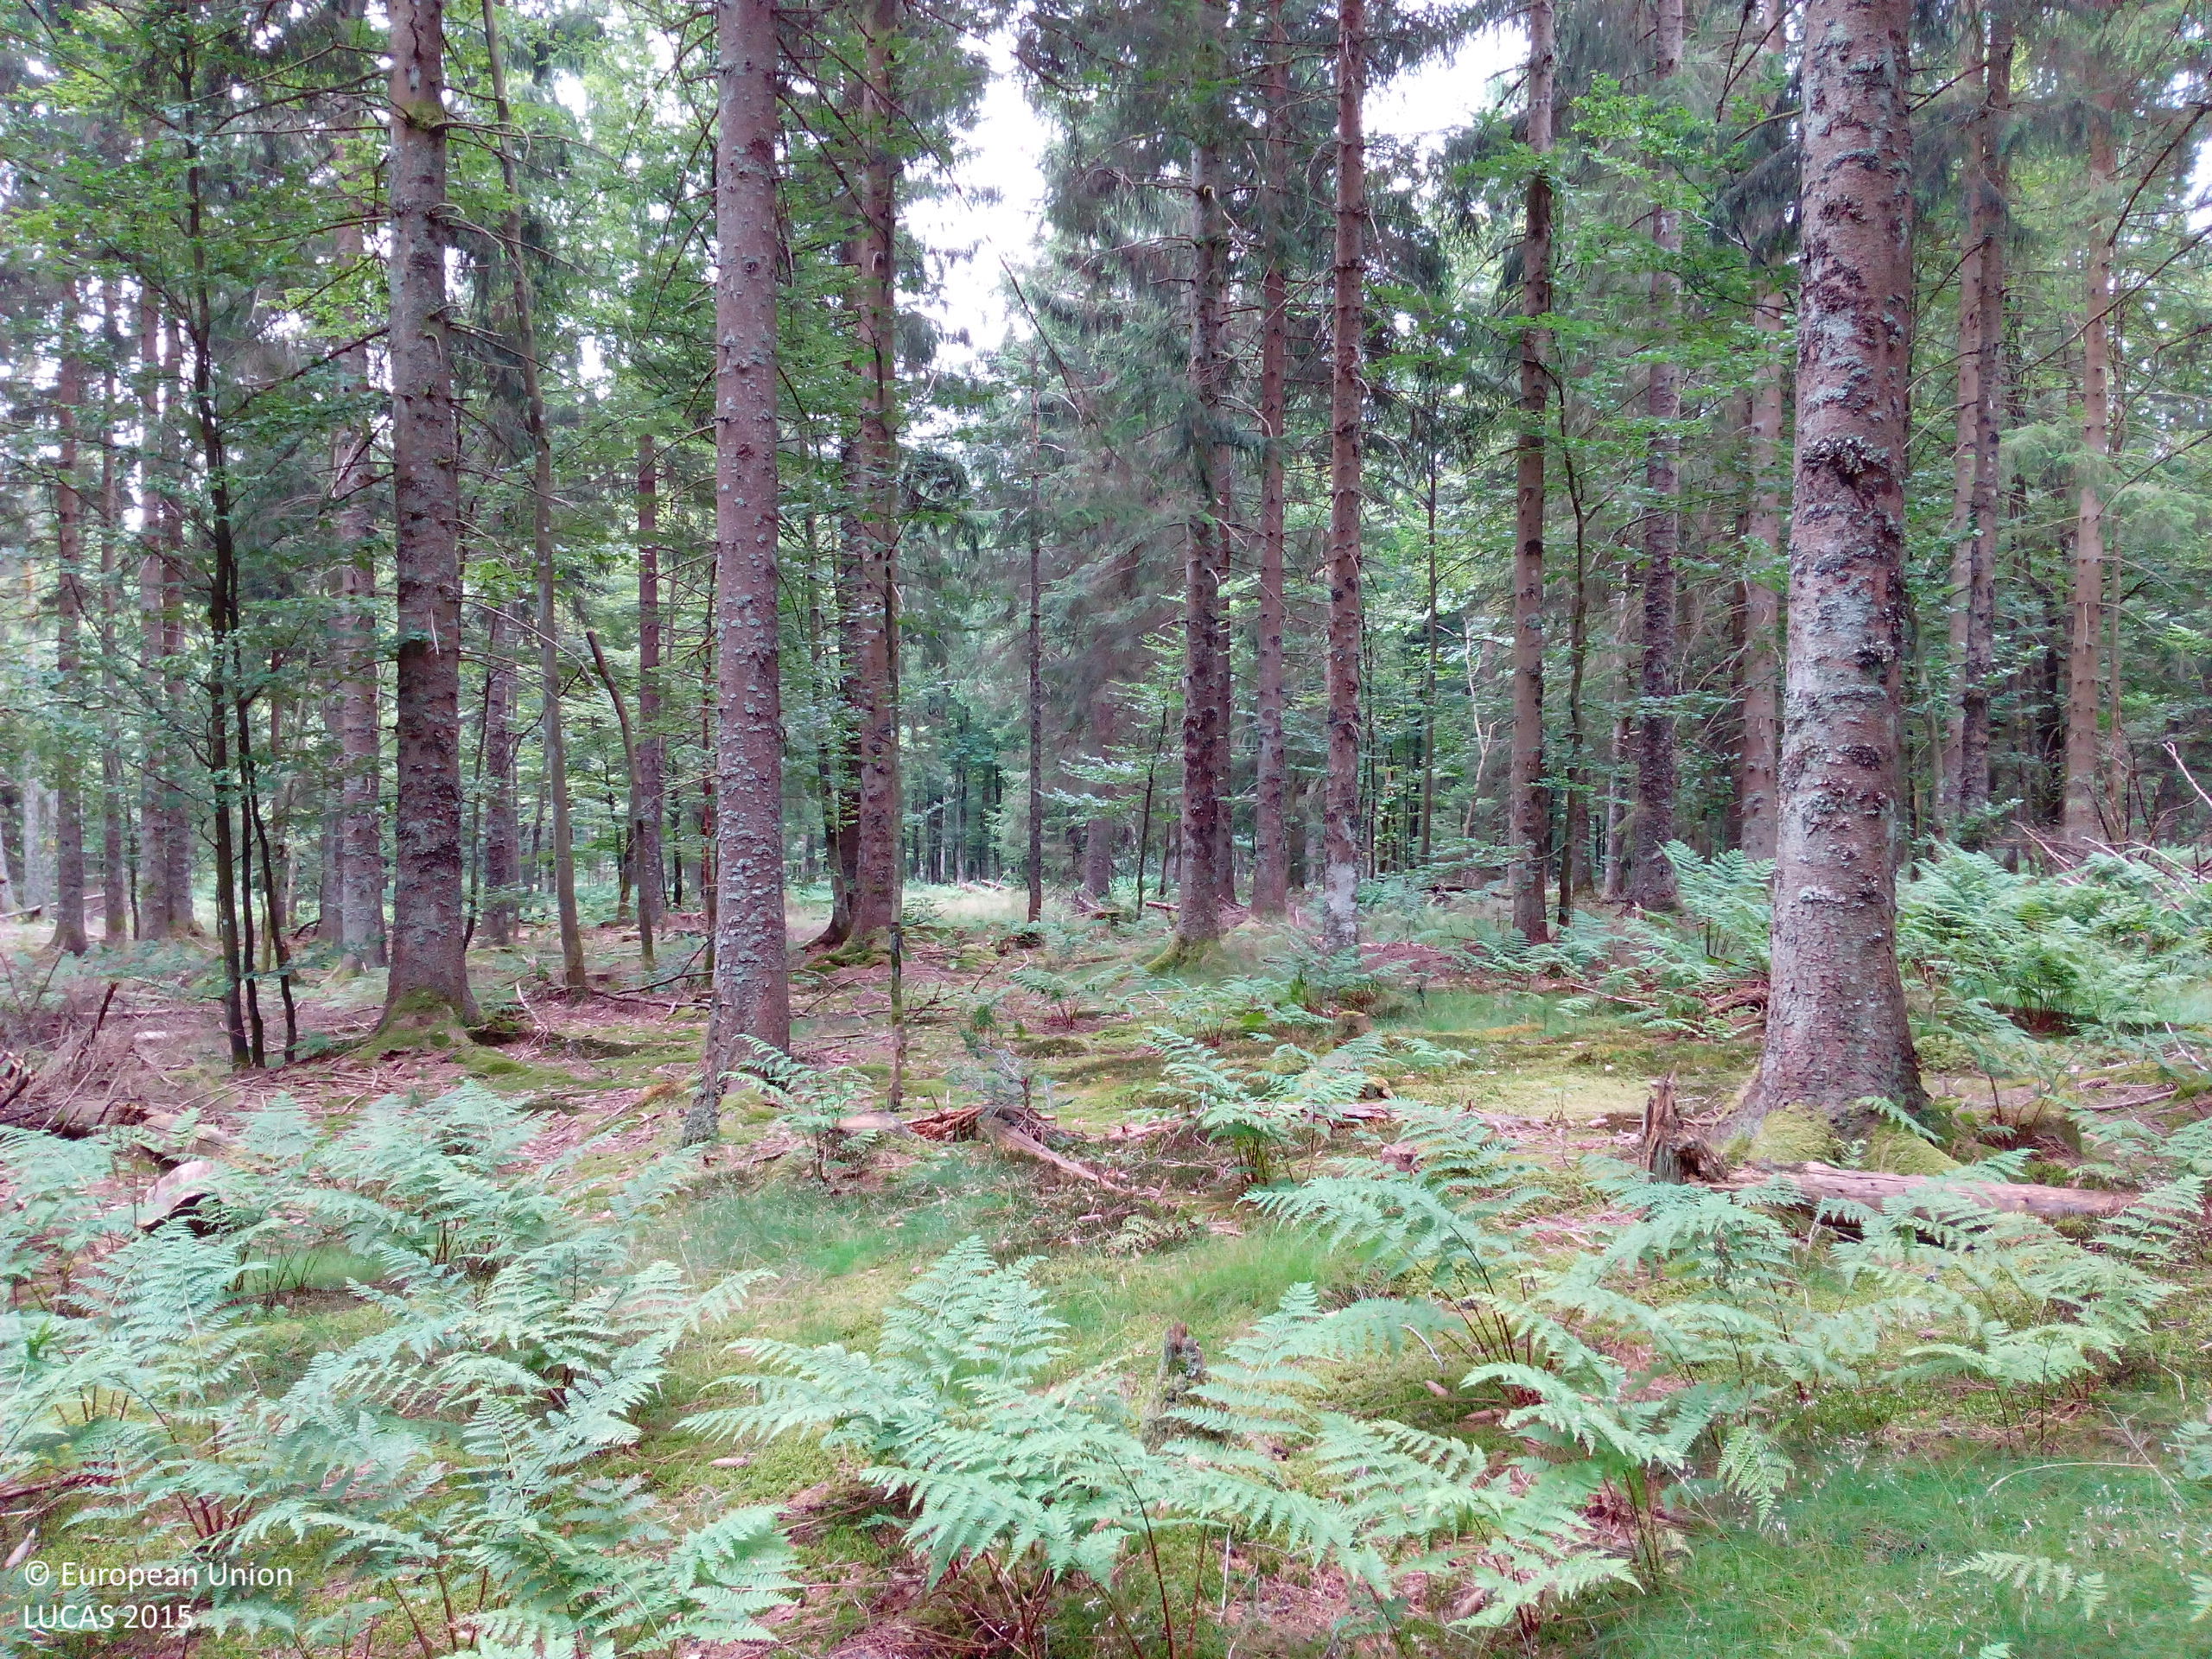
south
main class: Woodland
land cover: Spruce dominated coniferous woodland
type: hemiboreal forest and nemoral coniferous forest and mixed broadleaved-coniferous forest
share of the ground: 50 - 75 %
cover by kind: coniferous forest trees 65 %, herbaceous plants 15 %, lichens and mosses 10 %, broadleaved forest trees 5 %, shrubs 5 %
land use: Forestry
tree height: > 5 m
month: August
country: DE
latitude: 48.1178
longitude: 8.1338
